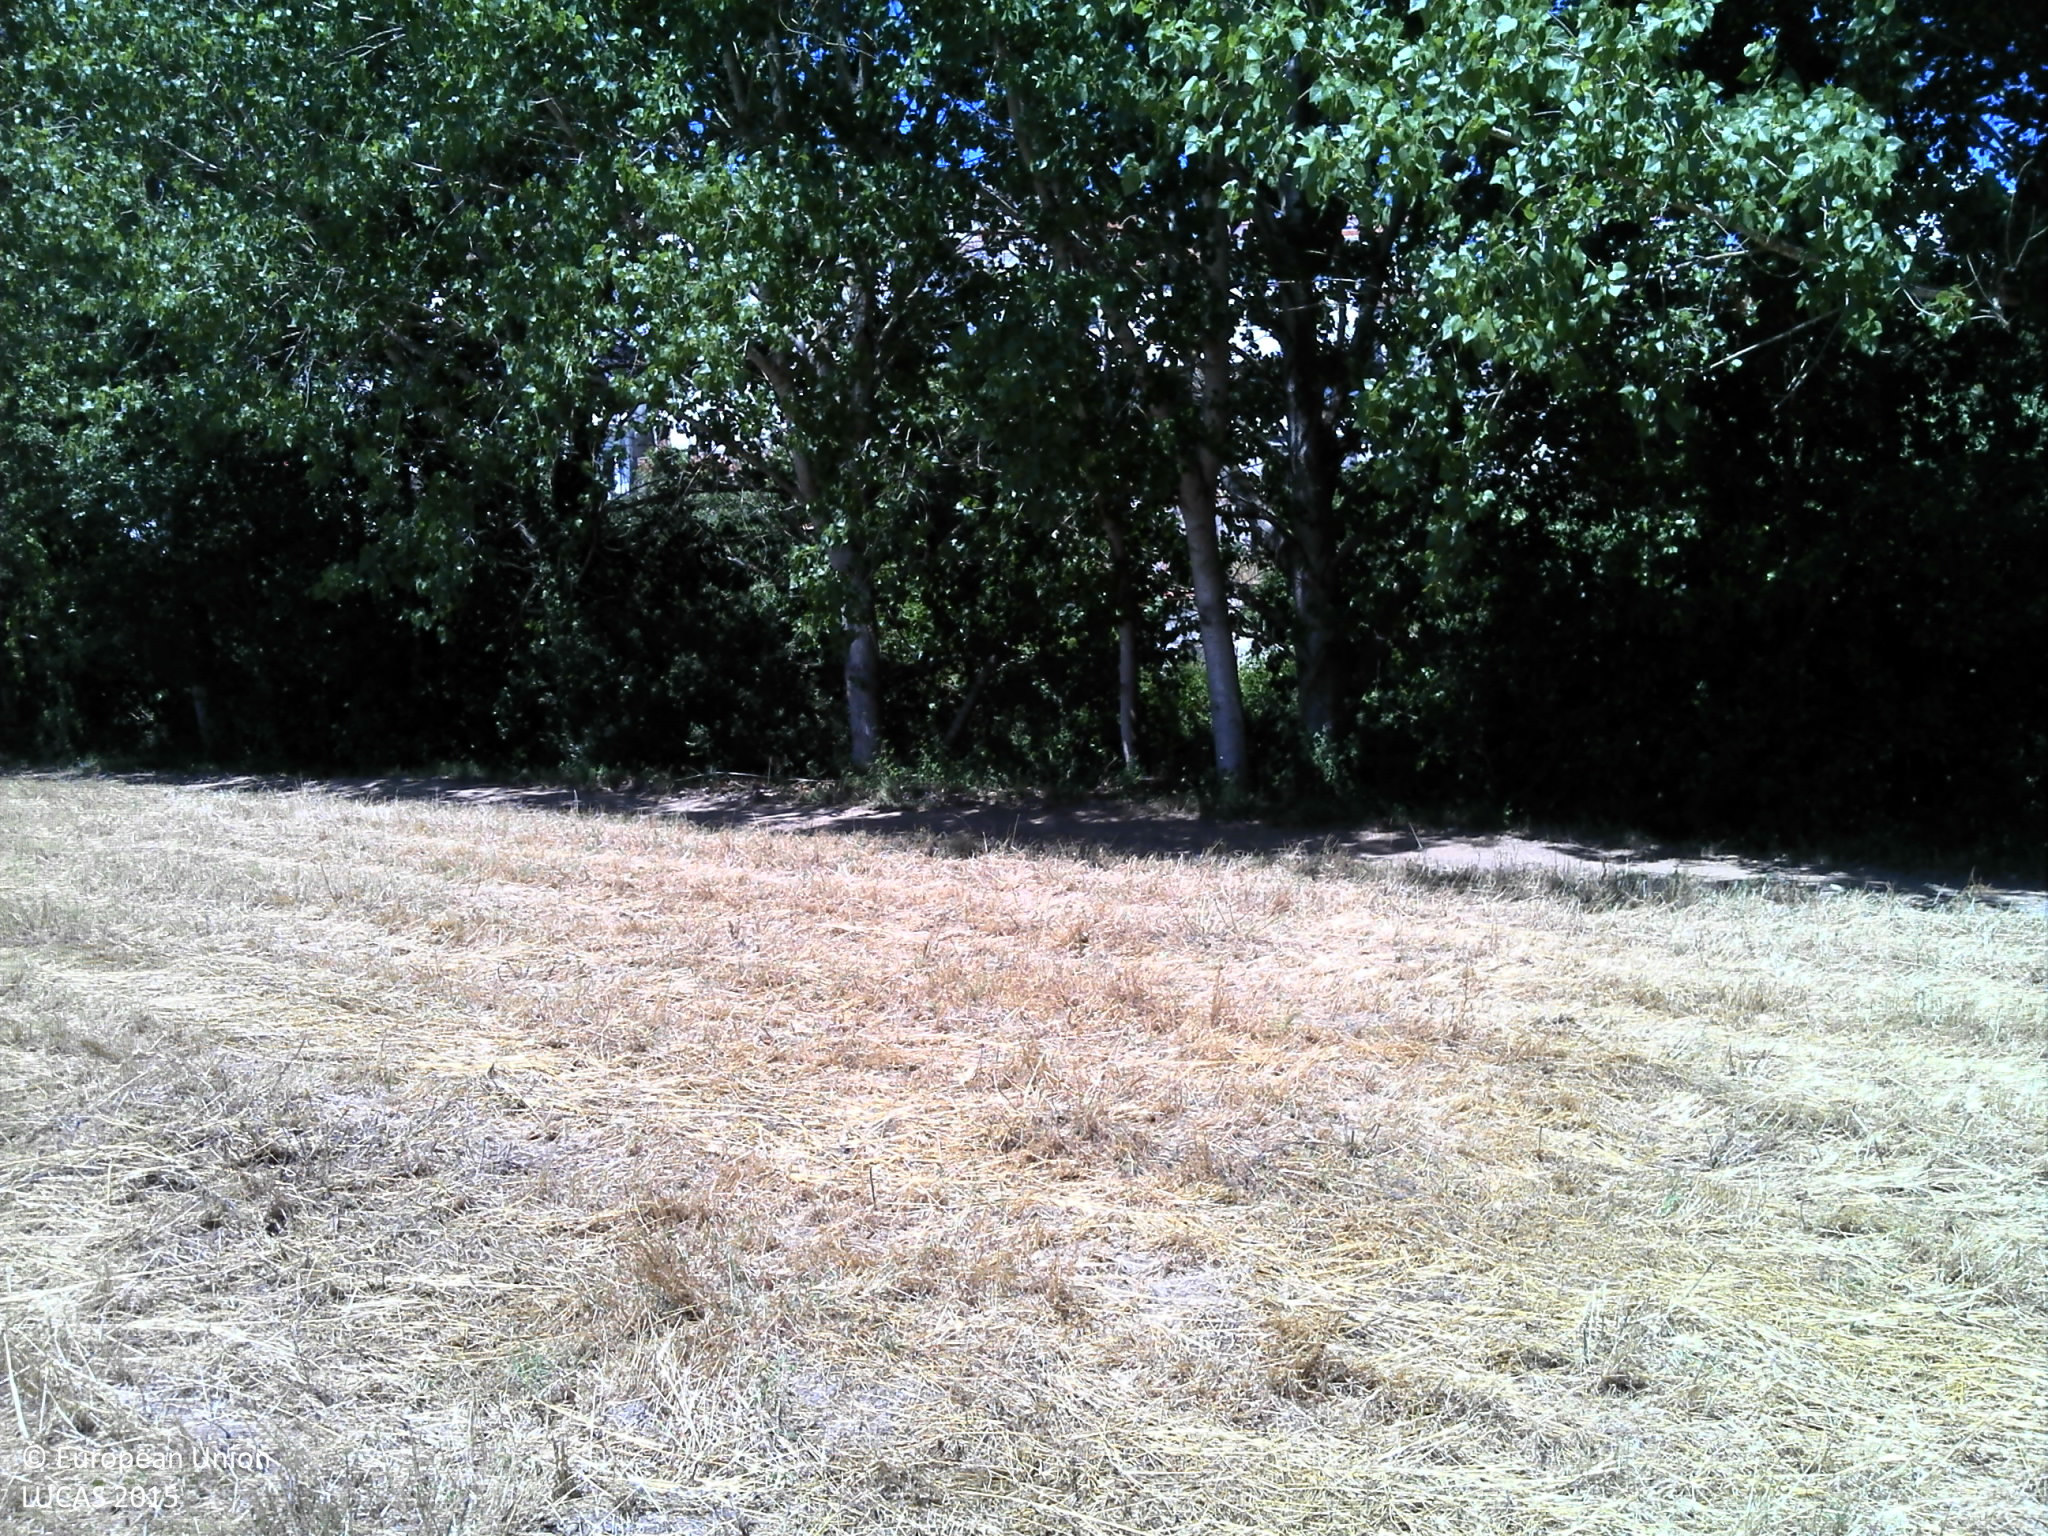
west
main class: Cropland
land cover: Durum wheat
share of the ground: 25 - 50 %
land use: Agriculture (excluding fallow land and kitchen gardens)
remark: Harvested field
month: June
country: PT
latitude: 37.3191
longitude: -8.8020
